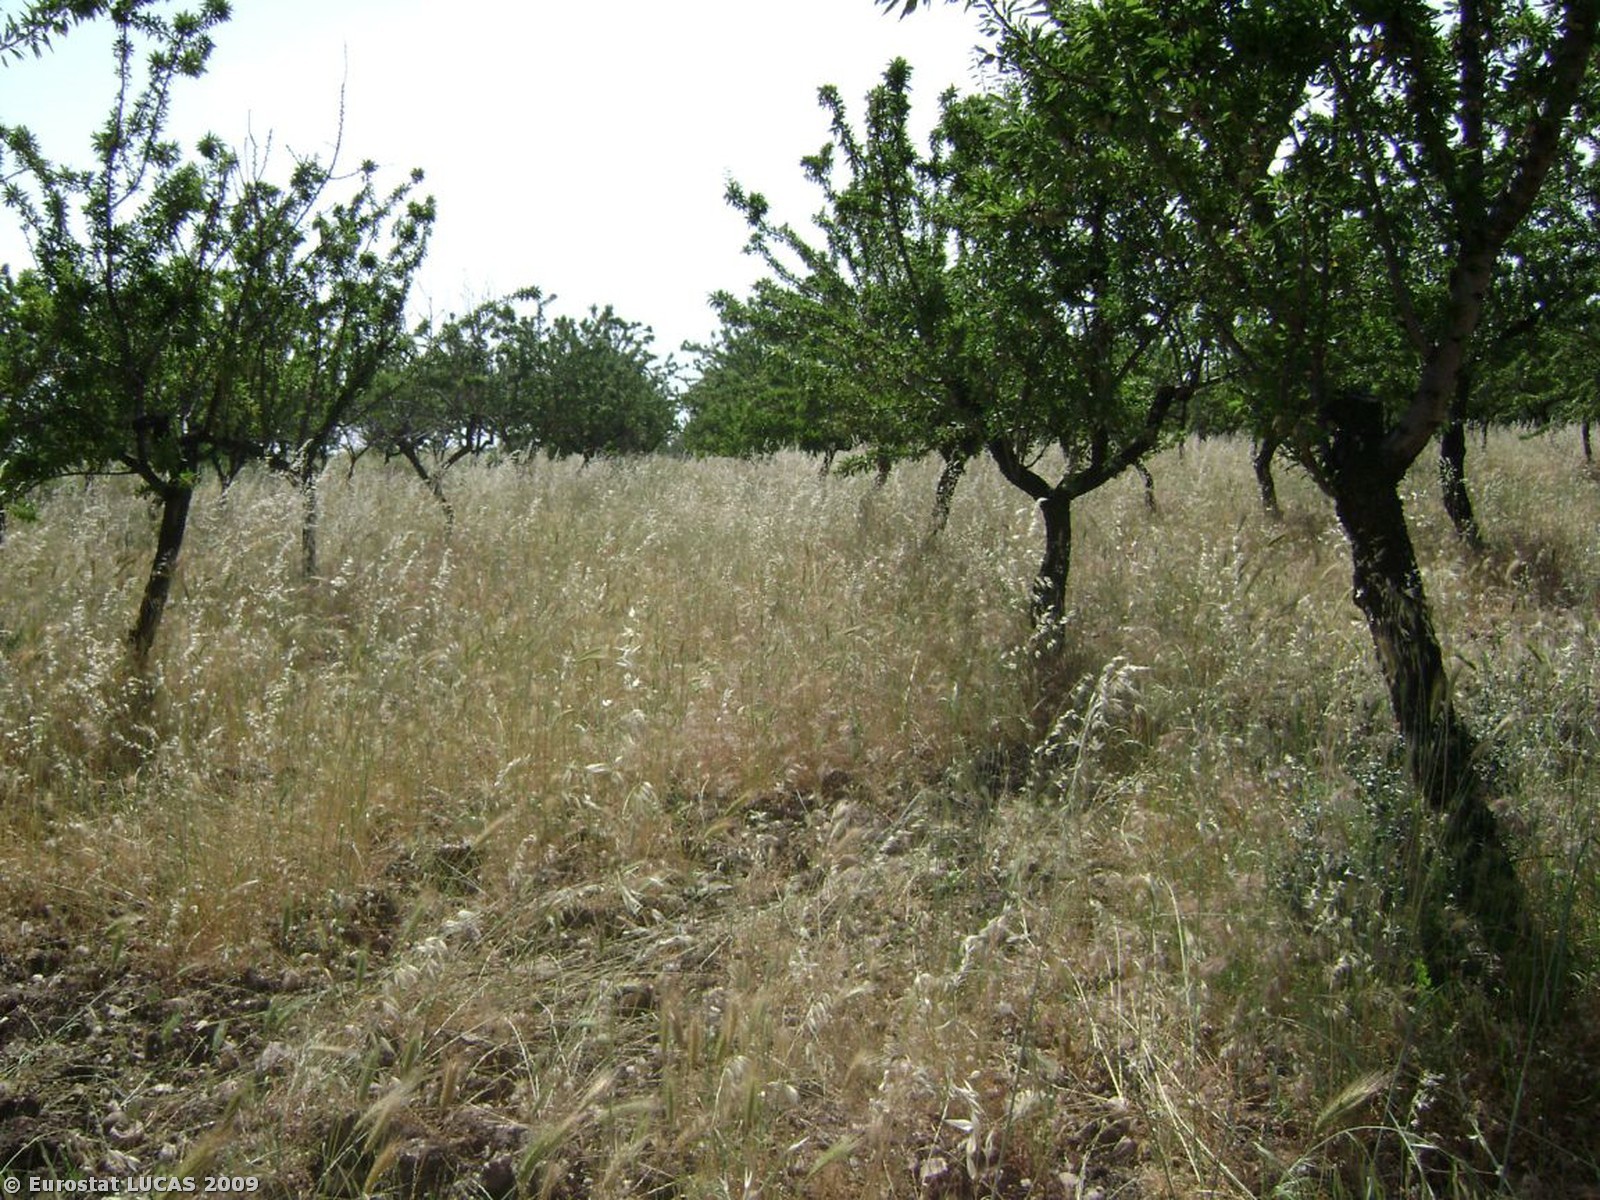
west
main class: Cropland
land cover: Nuts trees
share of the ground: 25 - 50 %
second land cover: Spontaneously vegetated surfaces
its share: > 75 %
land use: Agriculture (excluding fallow land and kitchen gardens)
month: May
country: IT
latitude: 41.6613
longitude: 15.6871
